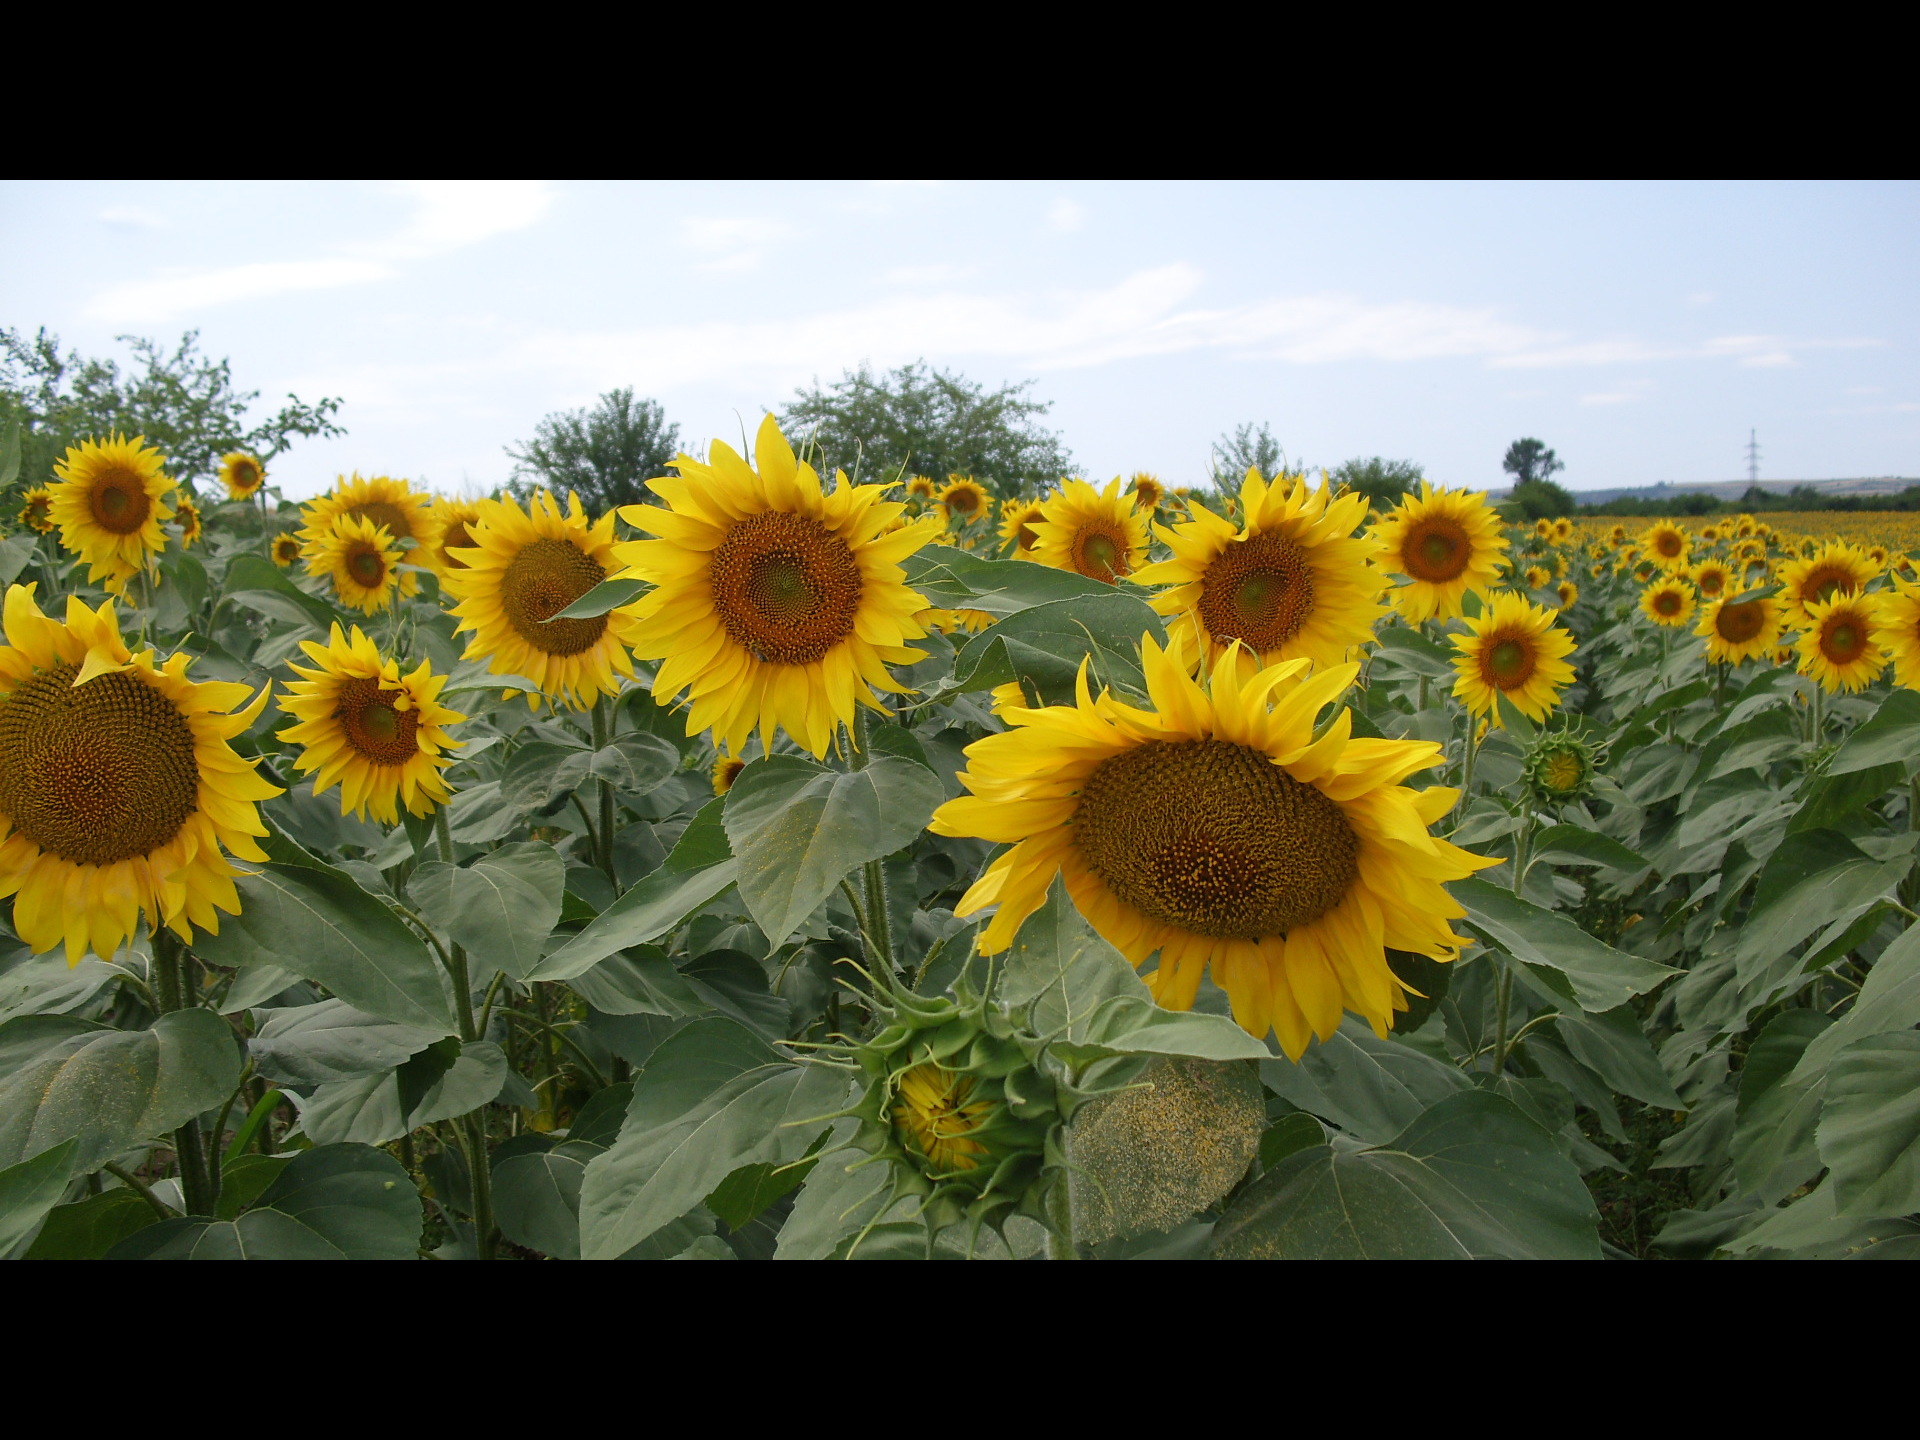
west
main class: Cropland
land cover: Sunflower
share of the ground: > 75 %
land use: Agriculture (excluding fallow land and kitchen gardens)
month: July
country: BG
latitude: 43.9688
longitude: 22.8398
